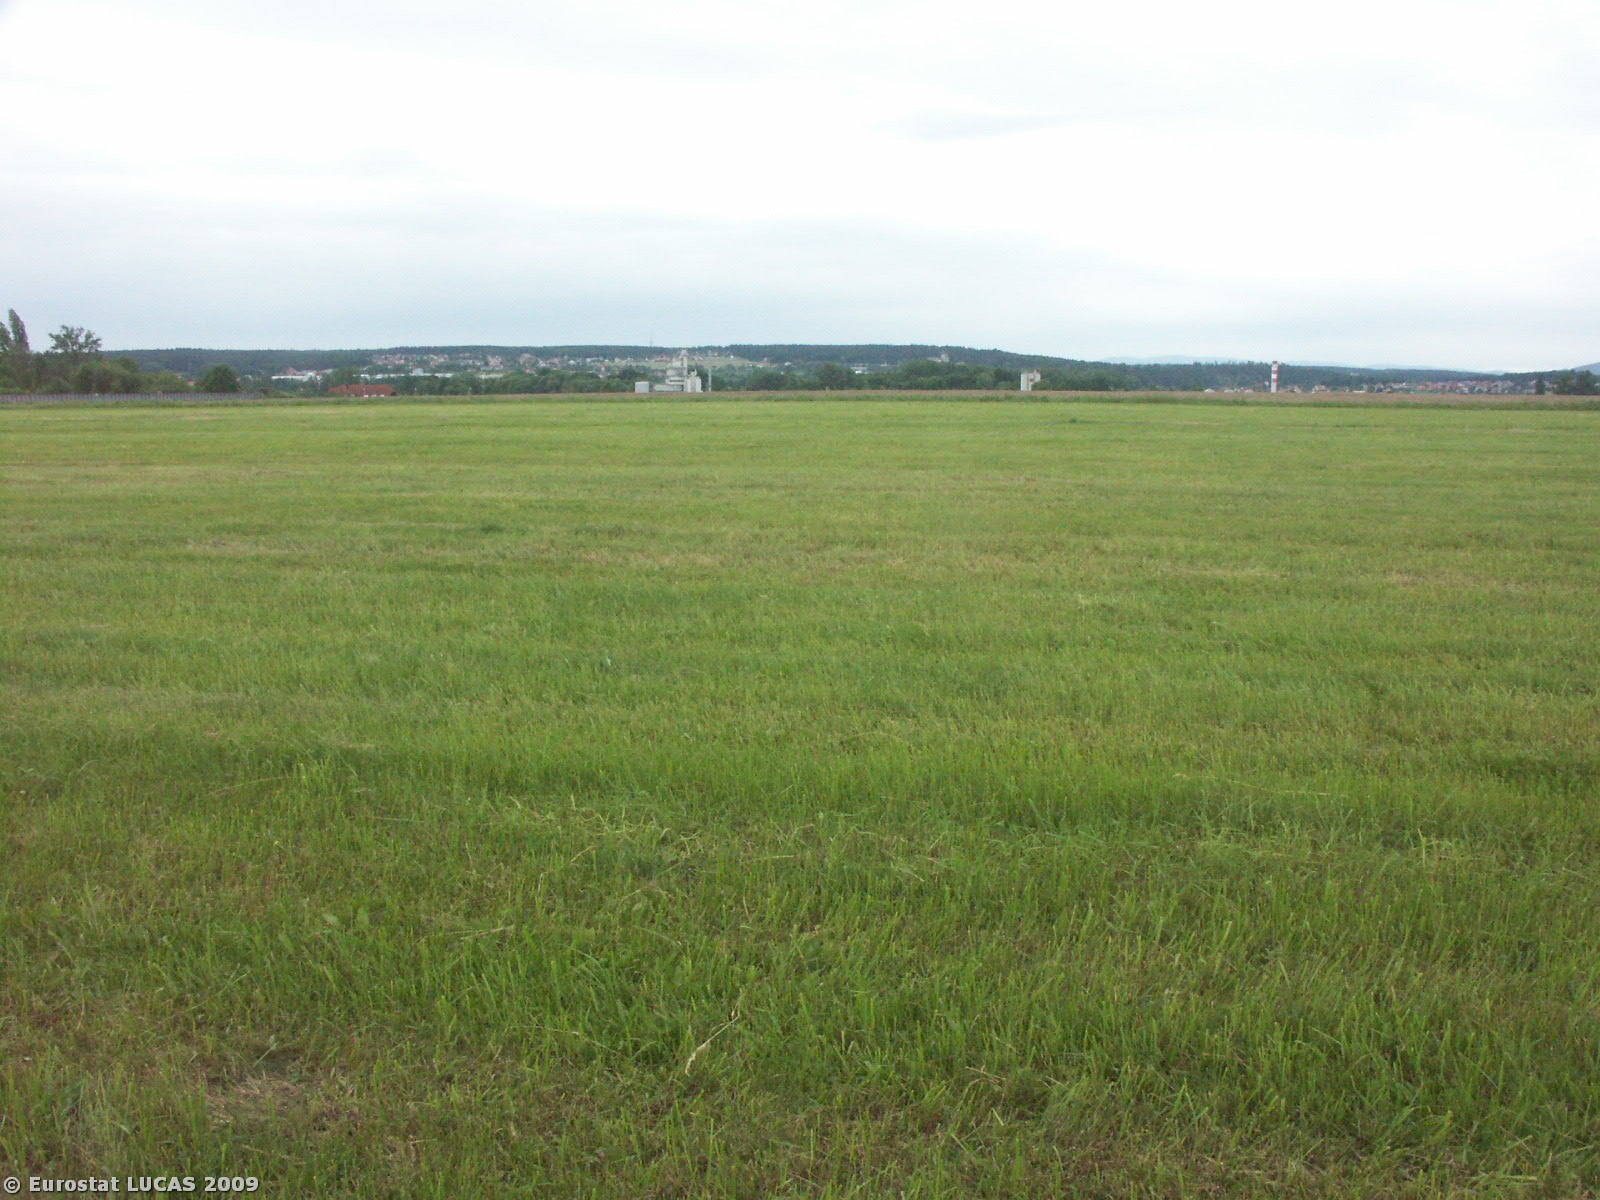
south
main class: Grassland
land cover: Grassland without tree/shrub cover
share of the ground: > 75 %
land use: Air transport
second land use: Community services
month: May
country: CZ
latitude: 48.9451
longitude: 14.4385
